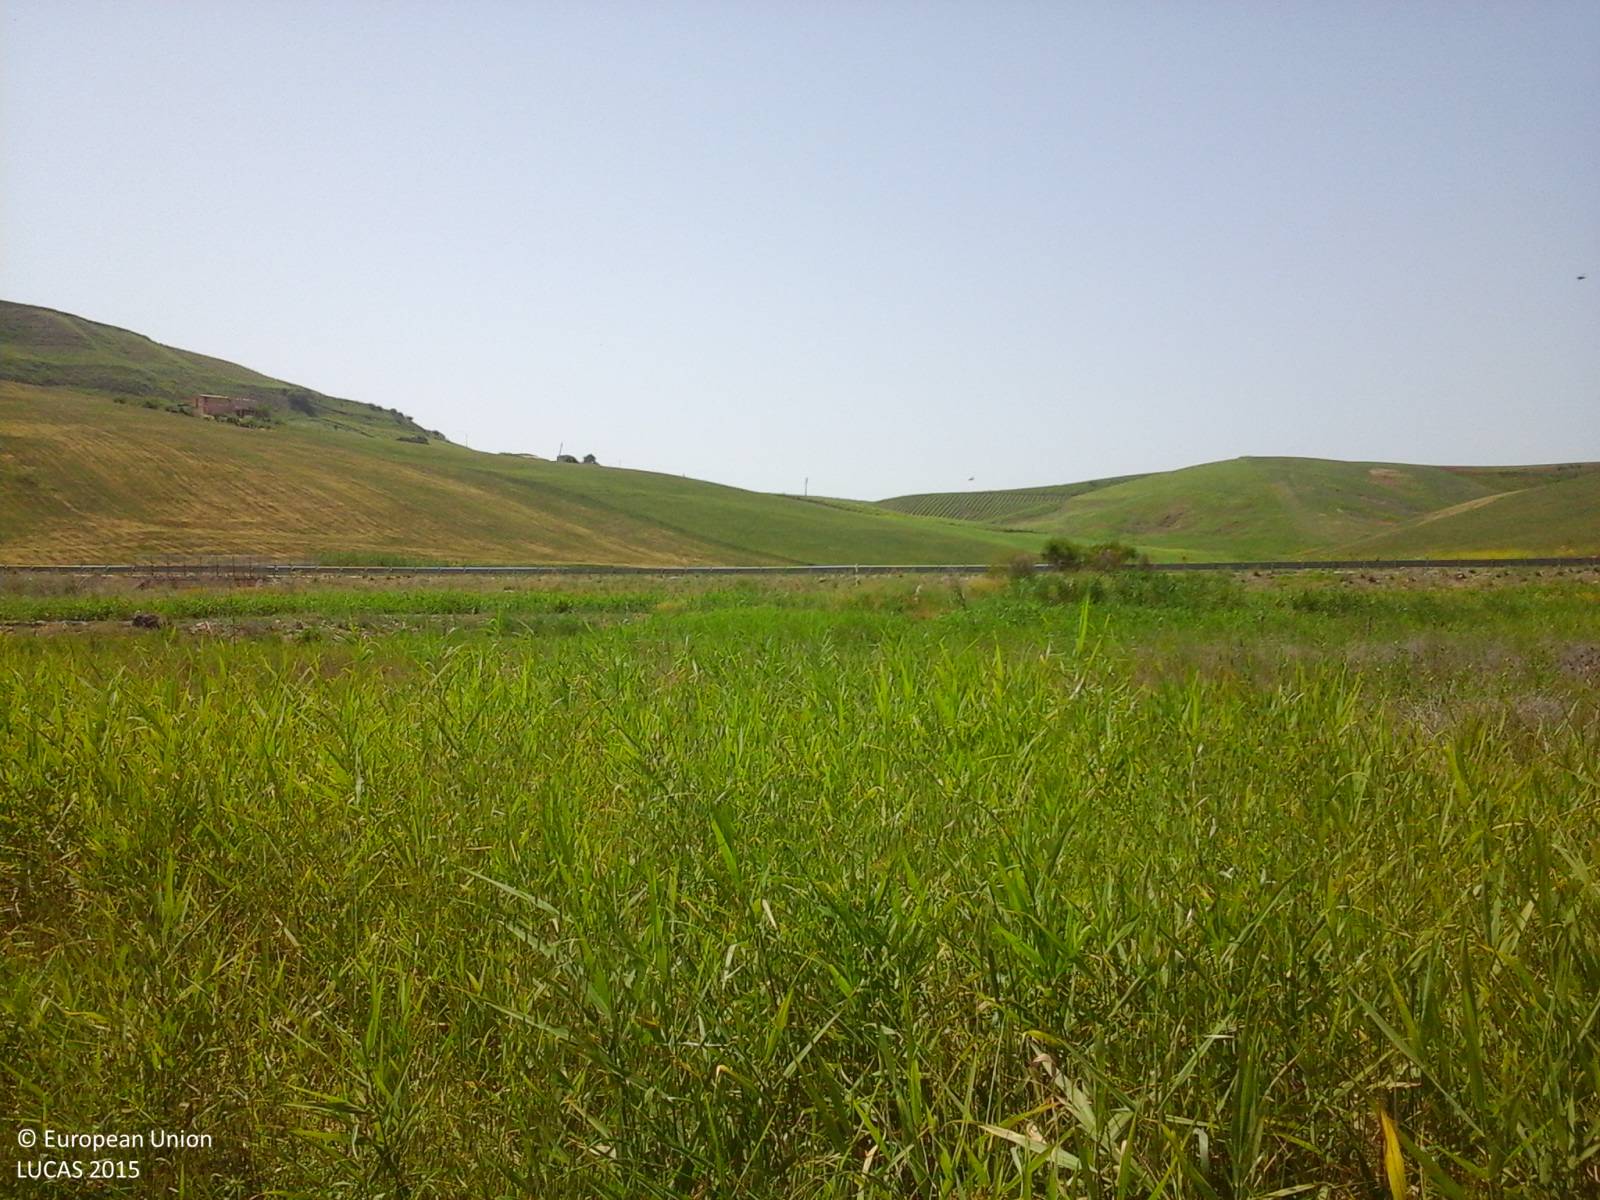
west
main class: Grassland
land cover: Spontaneously vegetated surfaces
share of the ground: > 75 %
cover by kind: herbaceous plants 100 %
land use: Fallow land
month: May
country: IT
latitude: 37.8597
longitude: 13.1256
